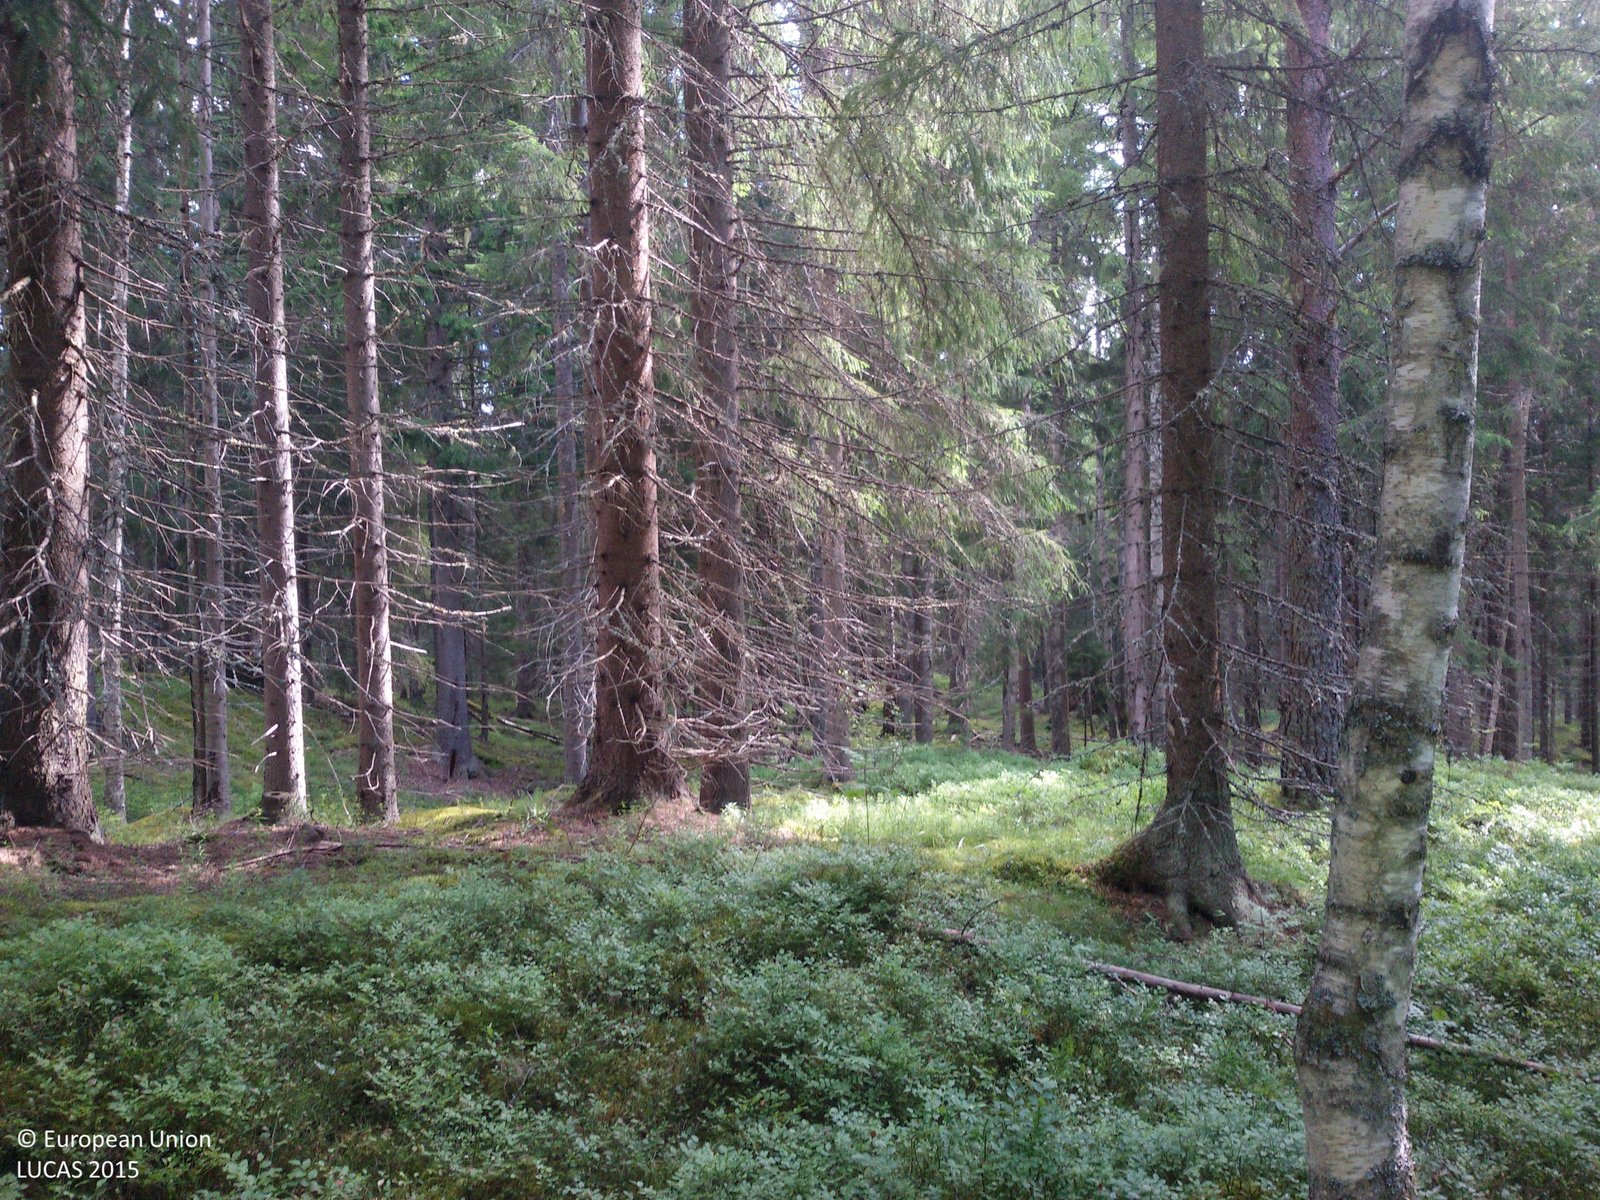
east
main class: Woodland
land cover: Spruce dominated coniferous woodland
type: boreal forest
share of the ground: > 75 %
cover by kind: coniferous forest trees 85 %, herbaceous plants 10 %, broadleaved forest trees 5 %
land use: Forestry
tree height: > 5 m
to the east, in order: Spruce dominated coniferous woodland; Rivers and streams; Spruce dominated coniferous woodland; Tracks; Spruce dominated coniferous woodland; Ditches and canals; Paved roads, cycling and walking lanes; Spruce dominated coniferous woodland
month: July
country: SE
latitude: 60.6251
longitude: 15.2325
